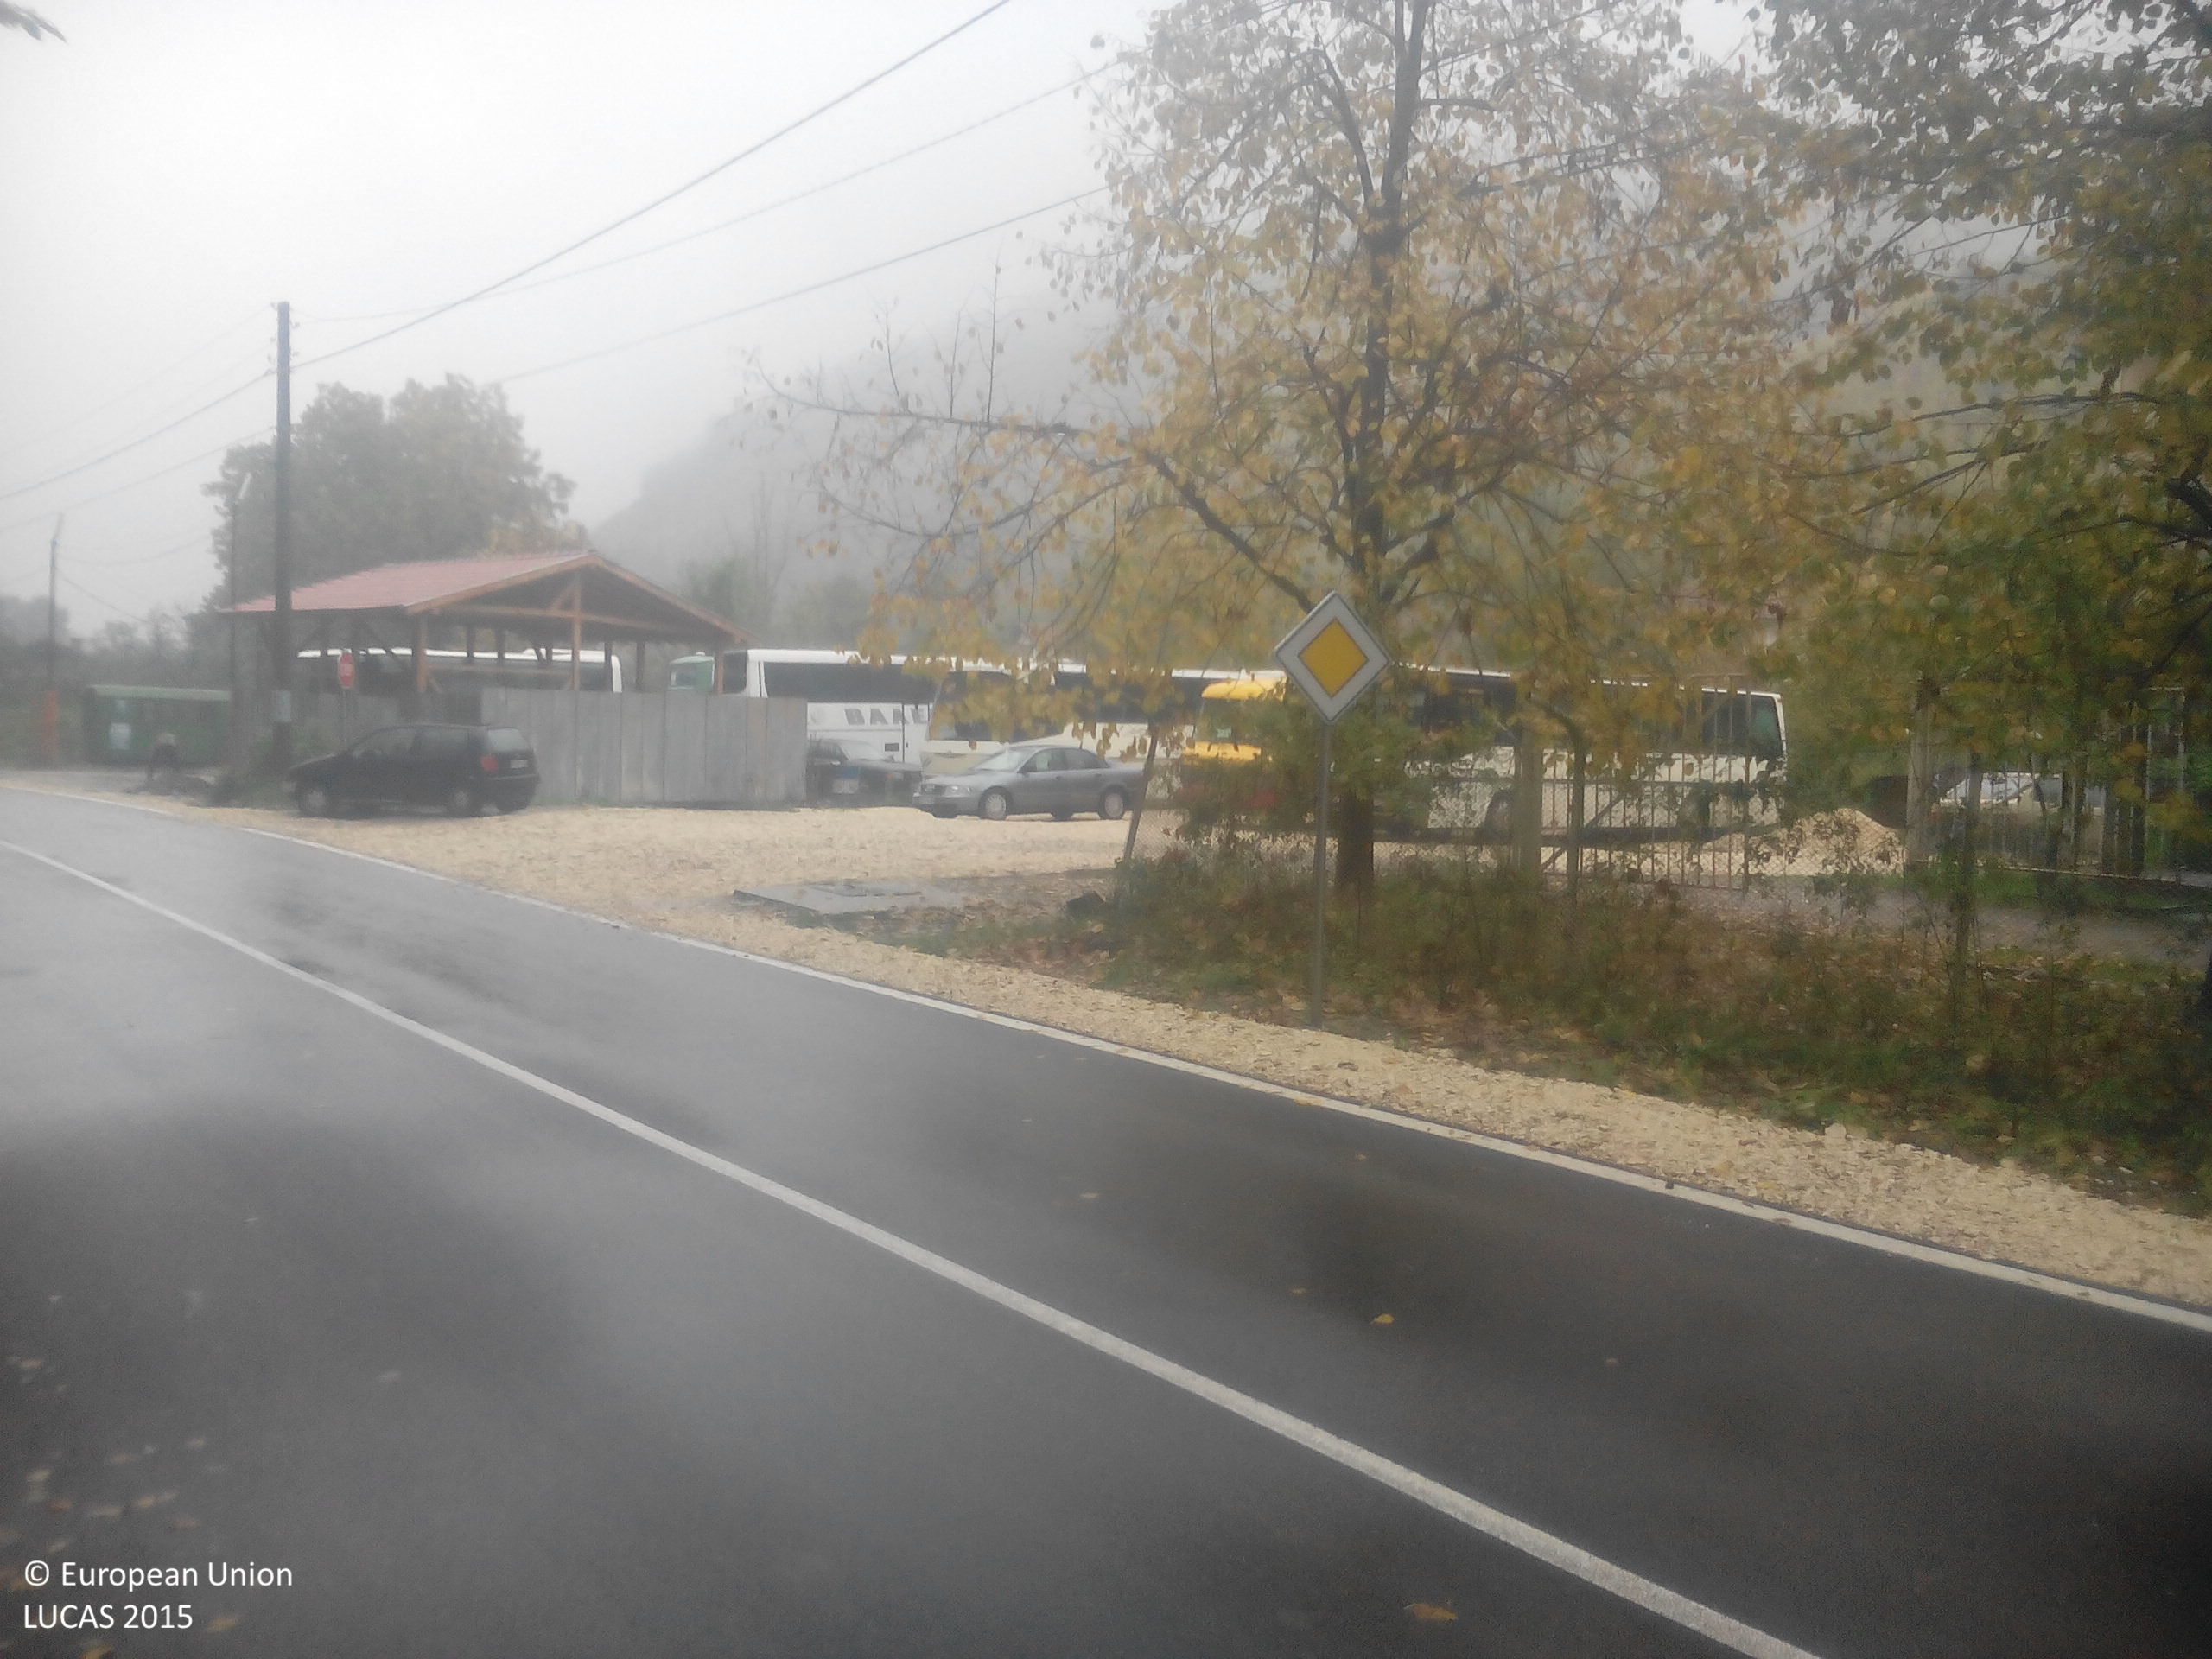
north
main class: Woodland
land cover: Broadleaved woodland
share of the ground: 50 - 75 %
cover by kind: broadleaved forest trees 70 %, herbaceous plants 20 %, shrubs 10 %
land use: Semi-natural and natural areas not in use
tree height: > 5 m
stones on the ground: < 10 %
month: October
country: BG
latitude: 42.9962
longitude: 24.2436
